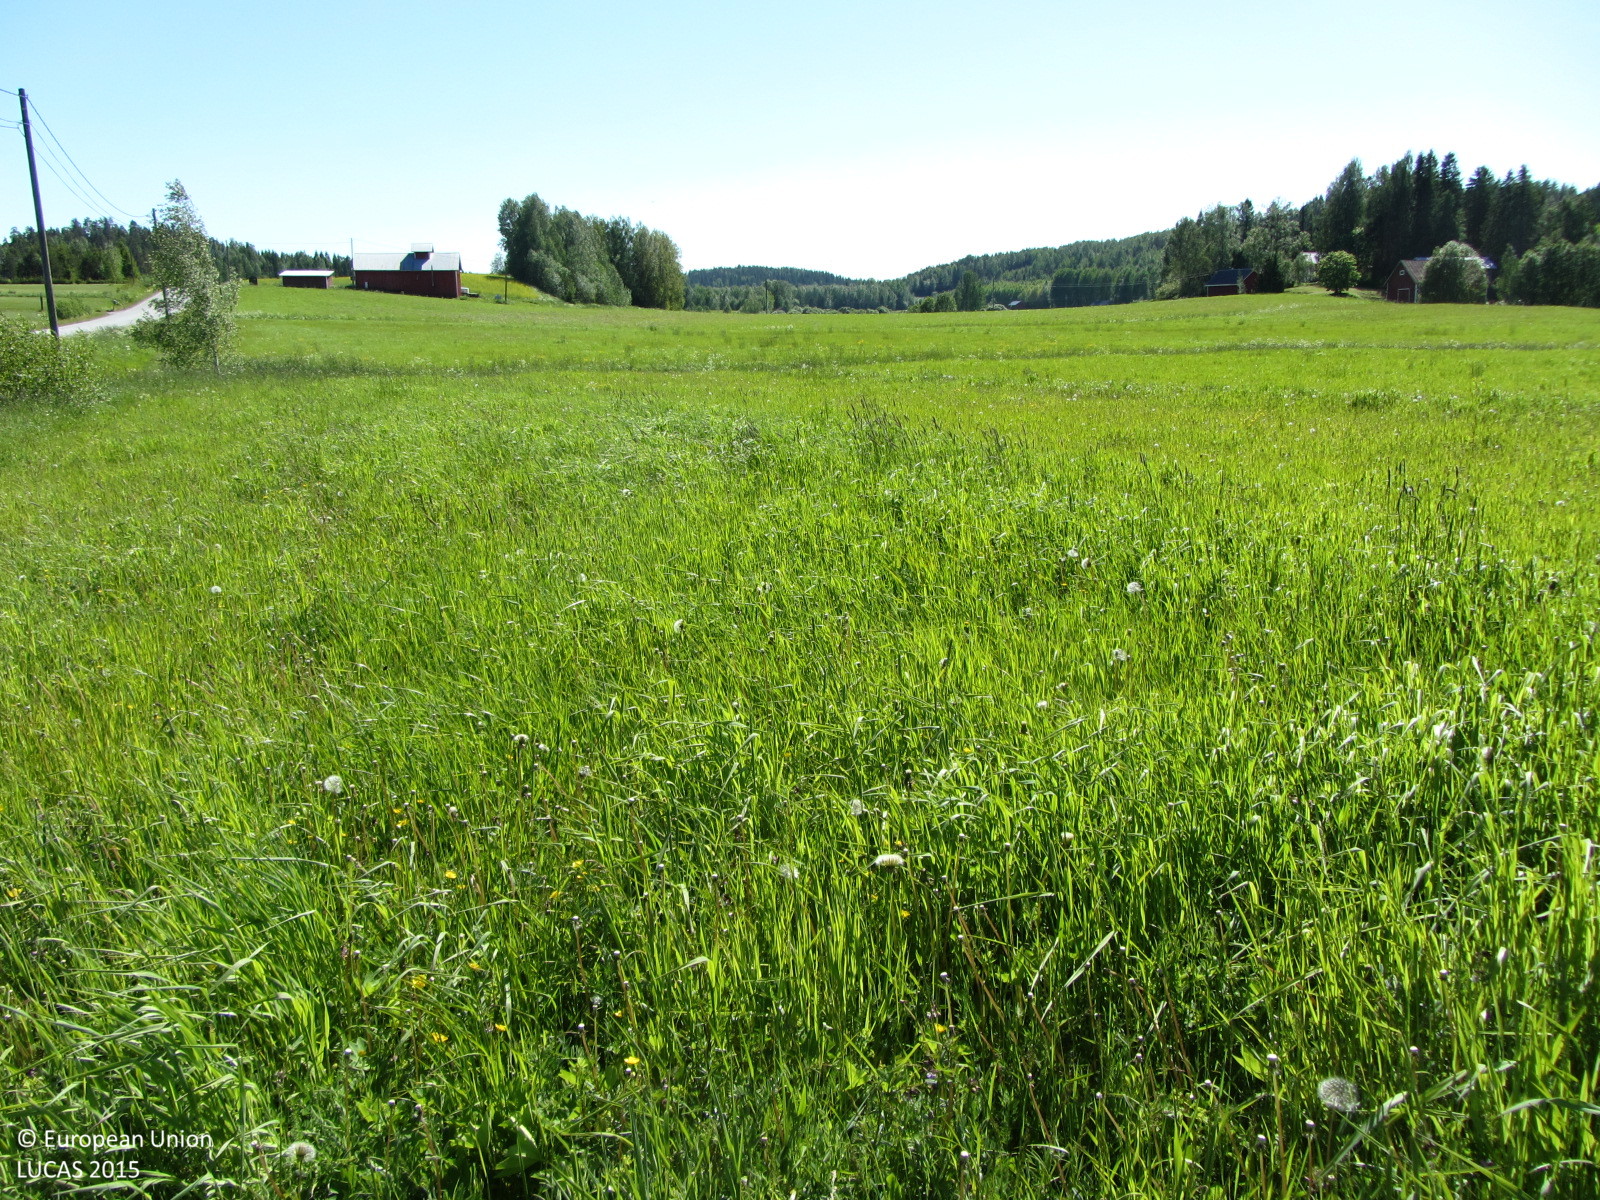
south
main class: Cropland
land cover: Temporary grasslands
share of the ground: > 75 %
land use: Agriculture (excluding fallow land and kitchen gardens)
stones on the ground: < 10 %
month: June
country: FI
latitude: 60.2725
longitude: 24.2957
